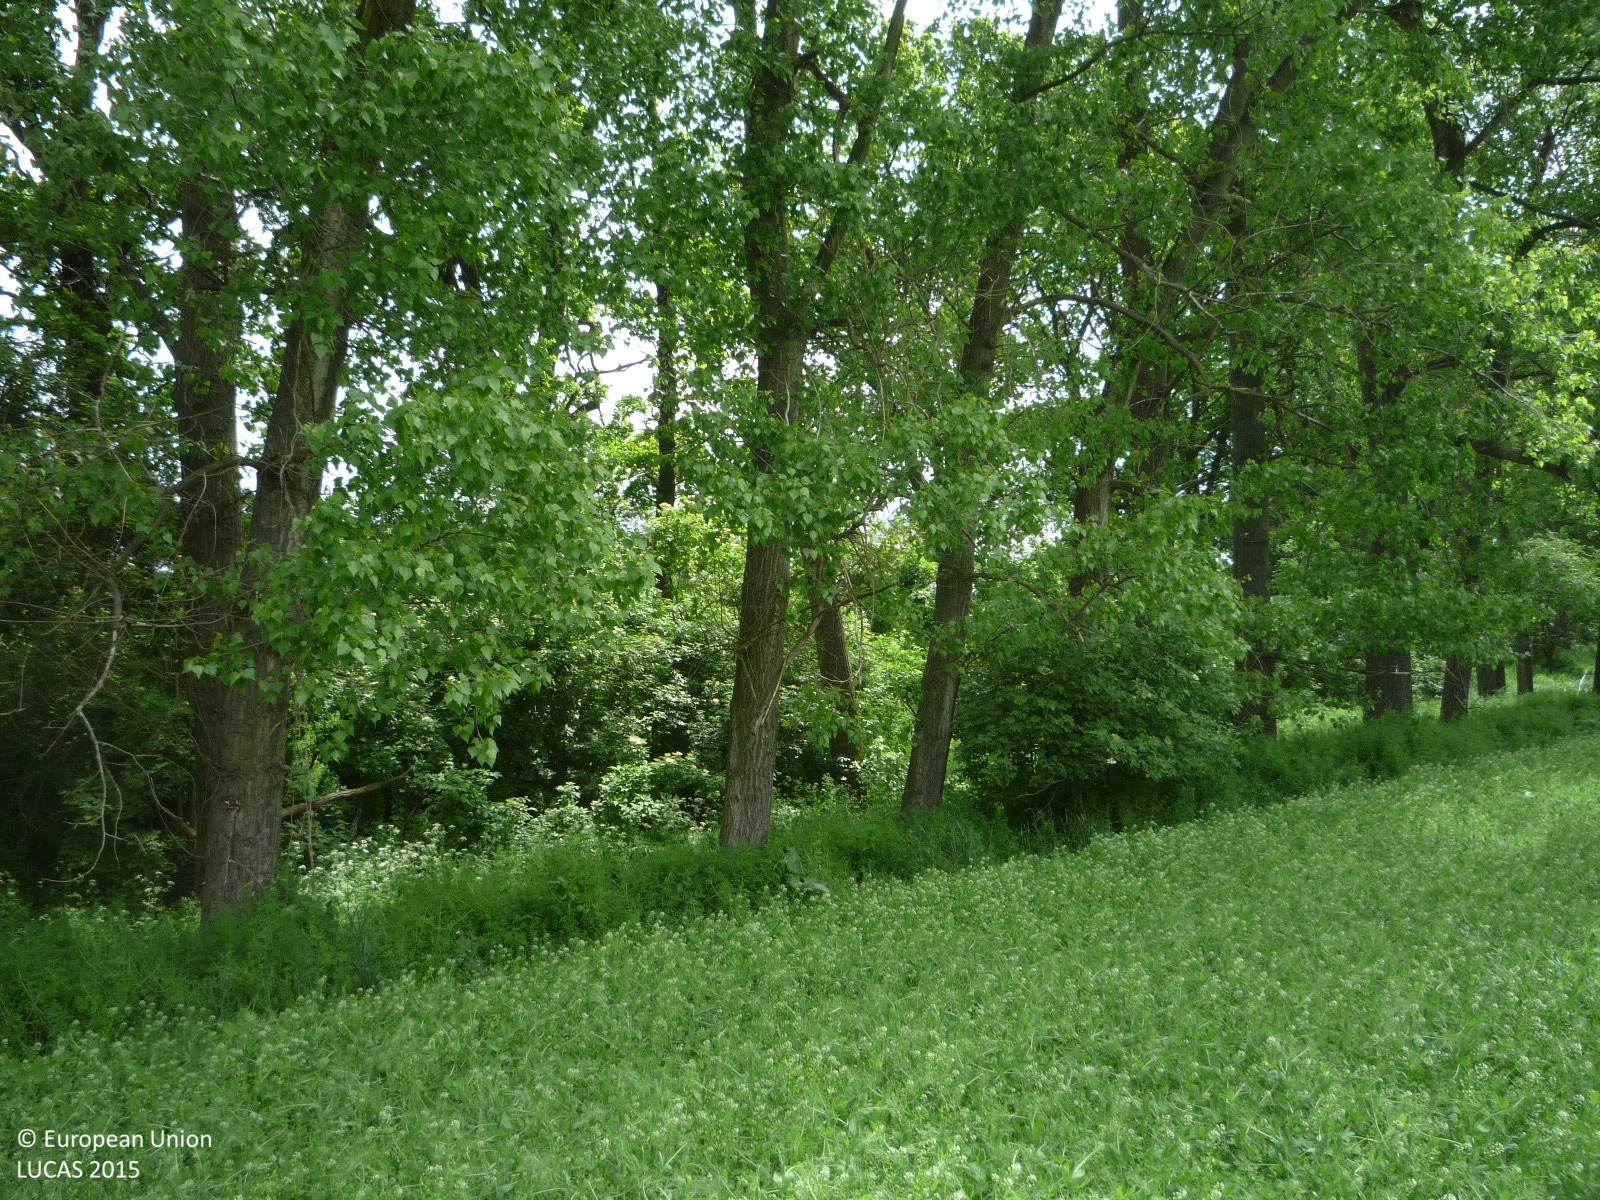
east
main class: Cropland
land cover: Other leguminous and mixtures for fodder
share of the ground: > 75 %
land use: Agriculture (excluding fallow land and kitchen gardens)
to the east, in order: Other leguminous and mixtures for fodder; Broadleaved woodland; Common wheat
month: May
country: CZ
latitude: 50.4098
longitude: 14.7443
